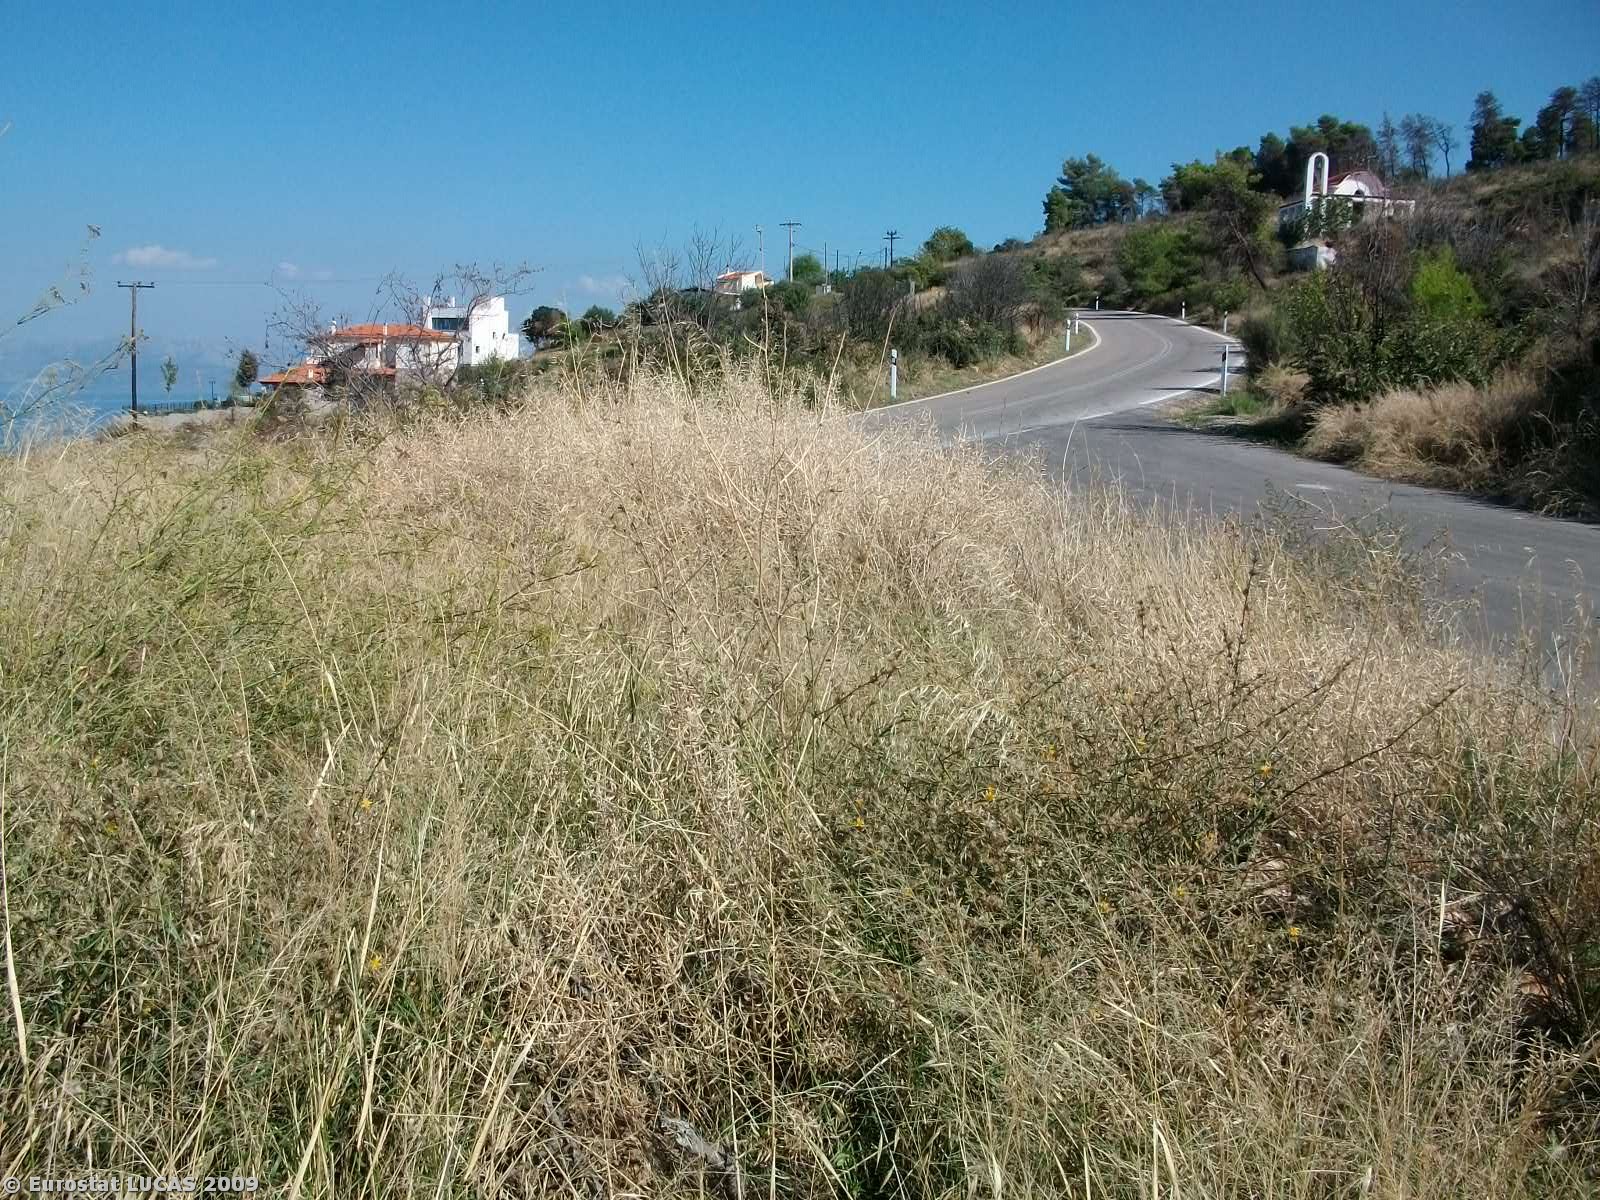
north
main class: Grassland
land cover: Grassland without tree/shrub cover
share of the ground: > 75 %
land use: Unused
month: September
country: GR
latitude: 38.2887
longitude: 23.8547
